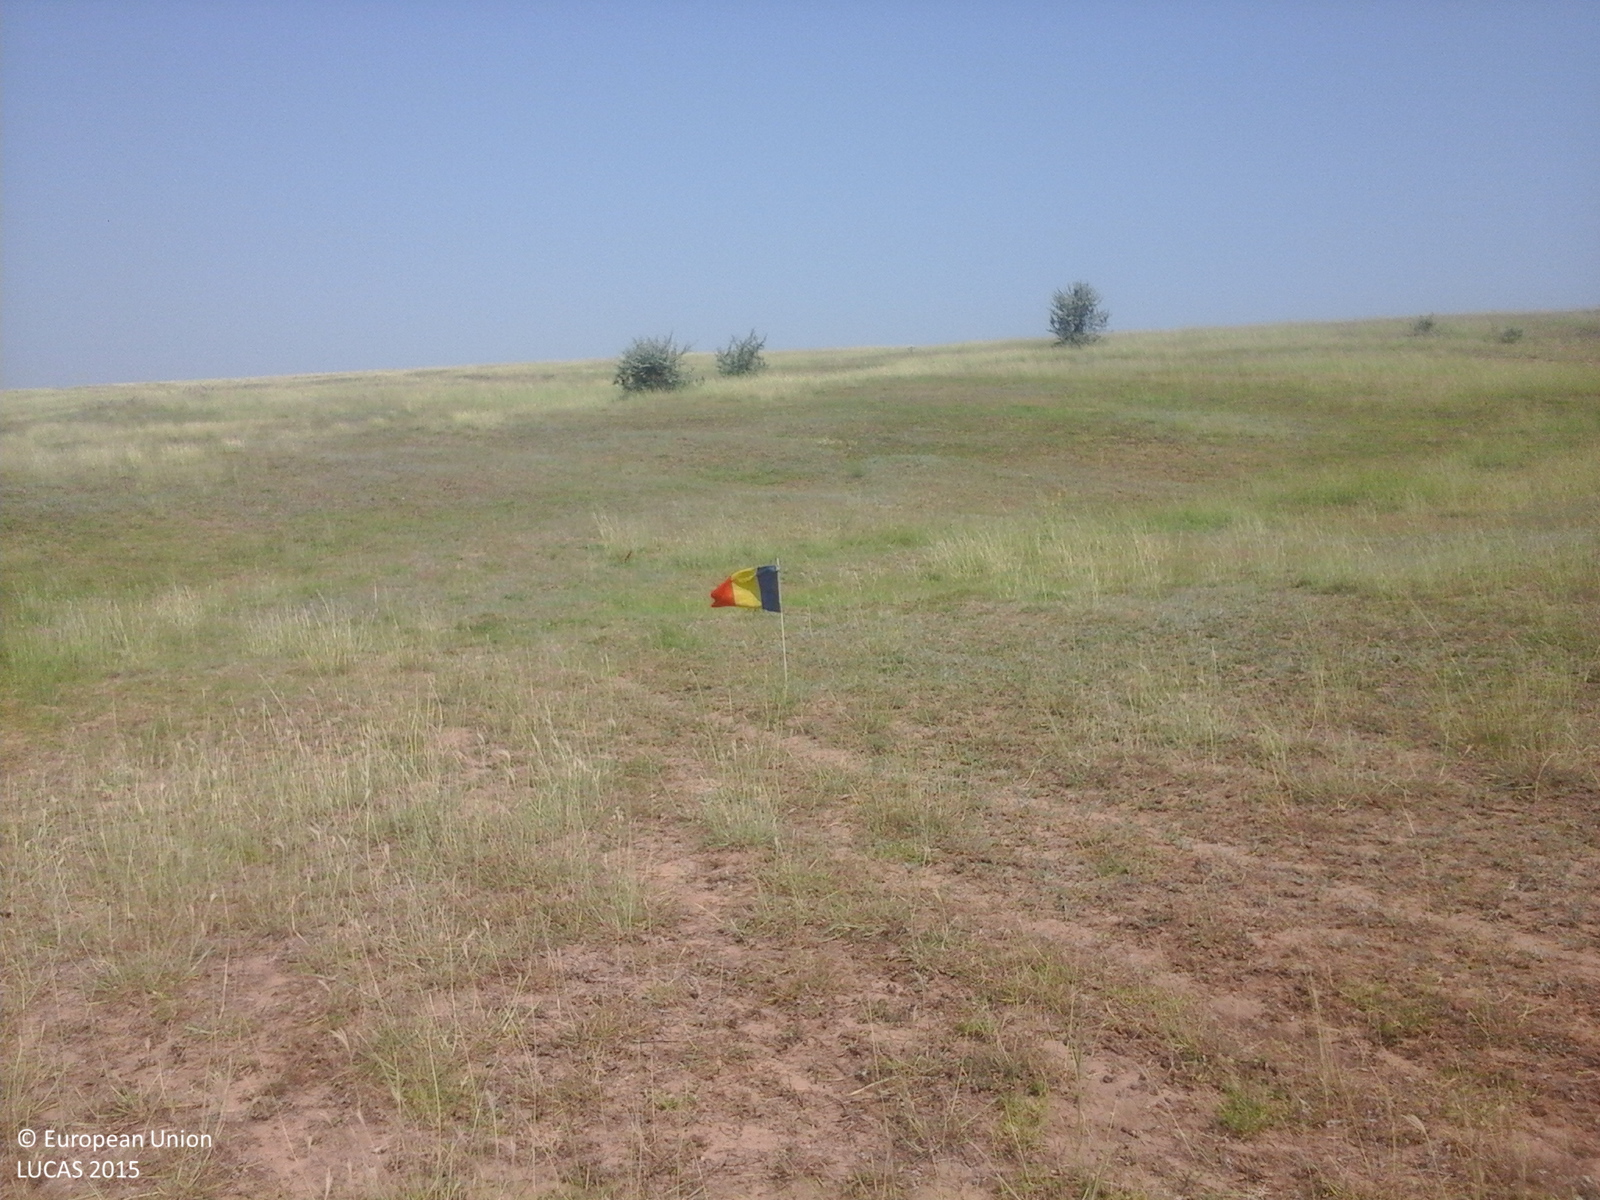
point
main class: Grassland
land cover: Grassland without tree/shrub cover
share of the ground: 50 - 75 %
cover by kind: herbaceous plants 100 %
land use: Agriculture (excluding fallow land and kitchen gardens)
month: July
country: RO
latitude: 45.8830
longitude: 27.9662
